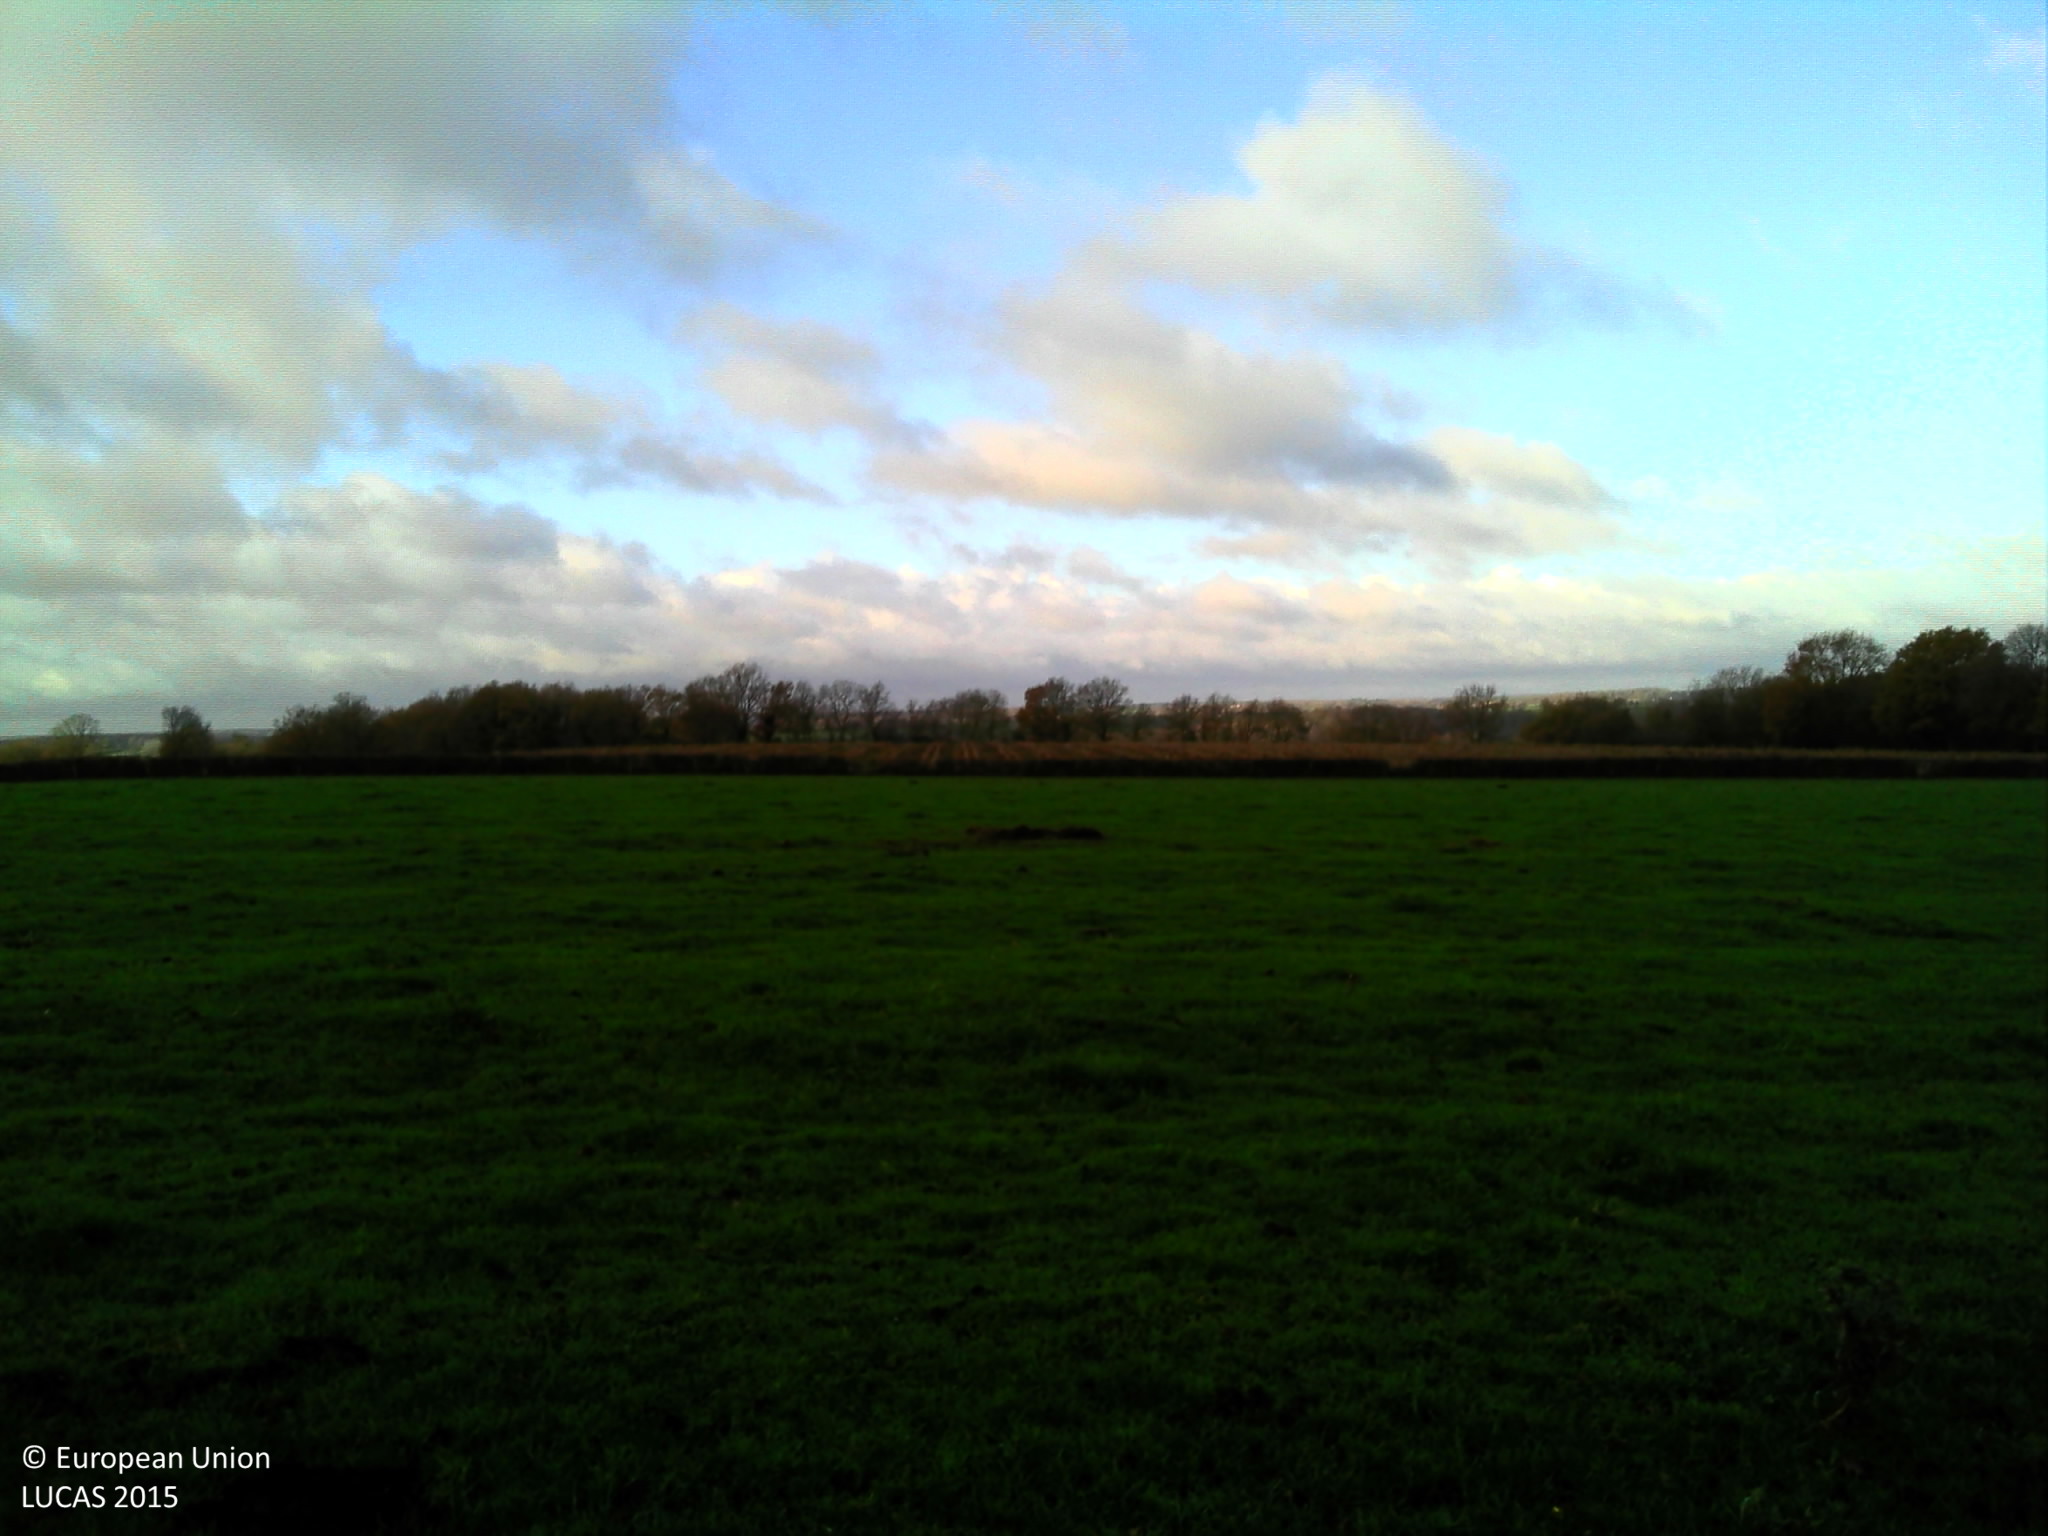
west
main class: Grassland
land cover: Grassland without tree/shrub cover
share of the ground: > 75 %
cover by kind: herbaceous plants 100 %
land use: Agriculture (excluding fallow land and kitchen gardens)
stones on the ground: < 10 %
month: August
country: FR
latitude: 46.4521
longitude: 3.6593
